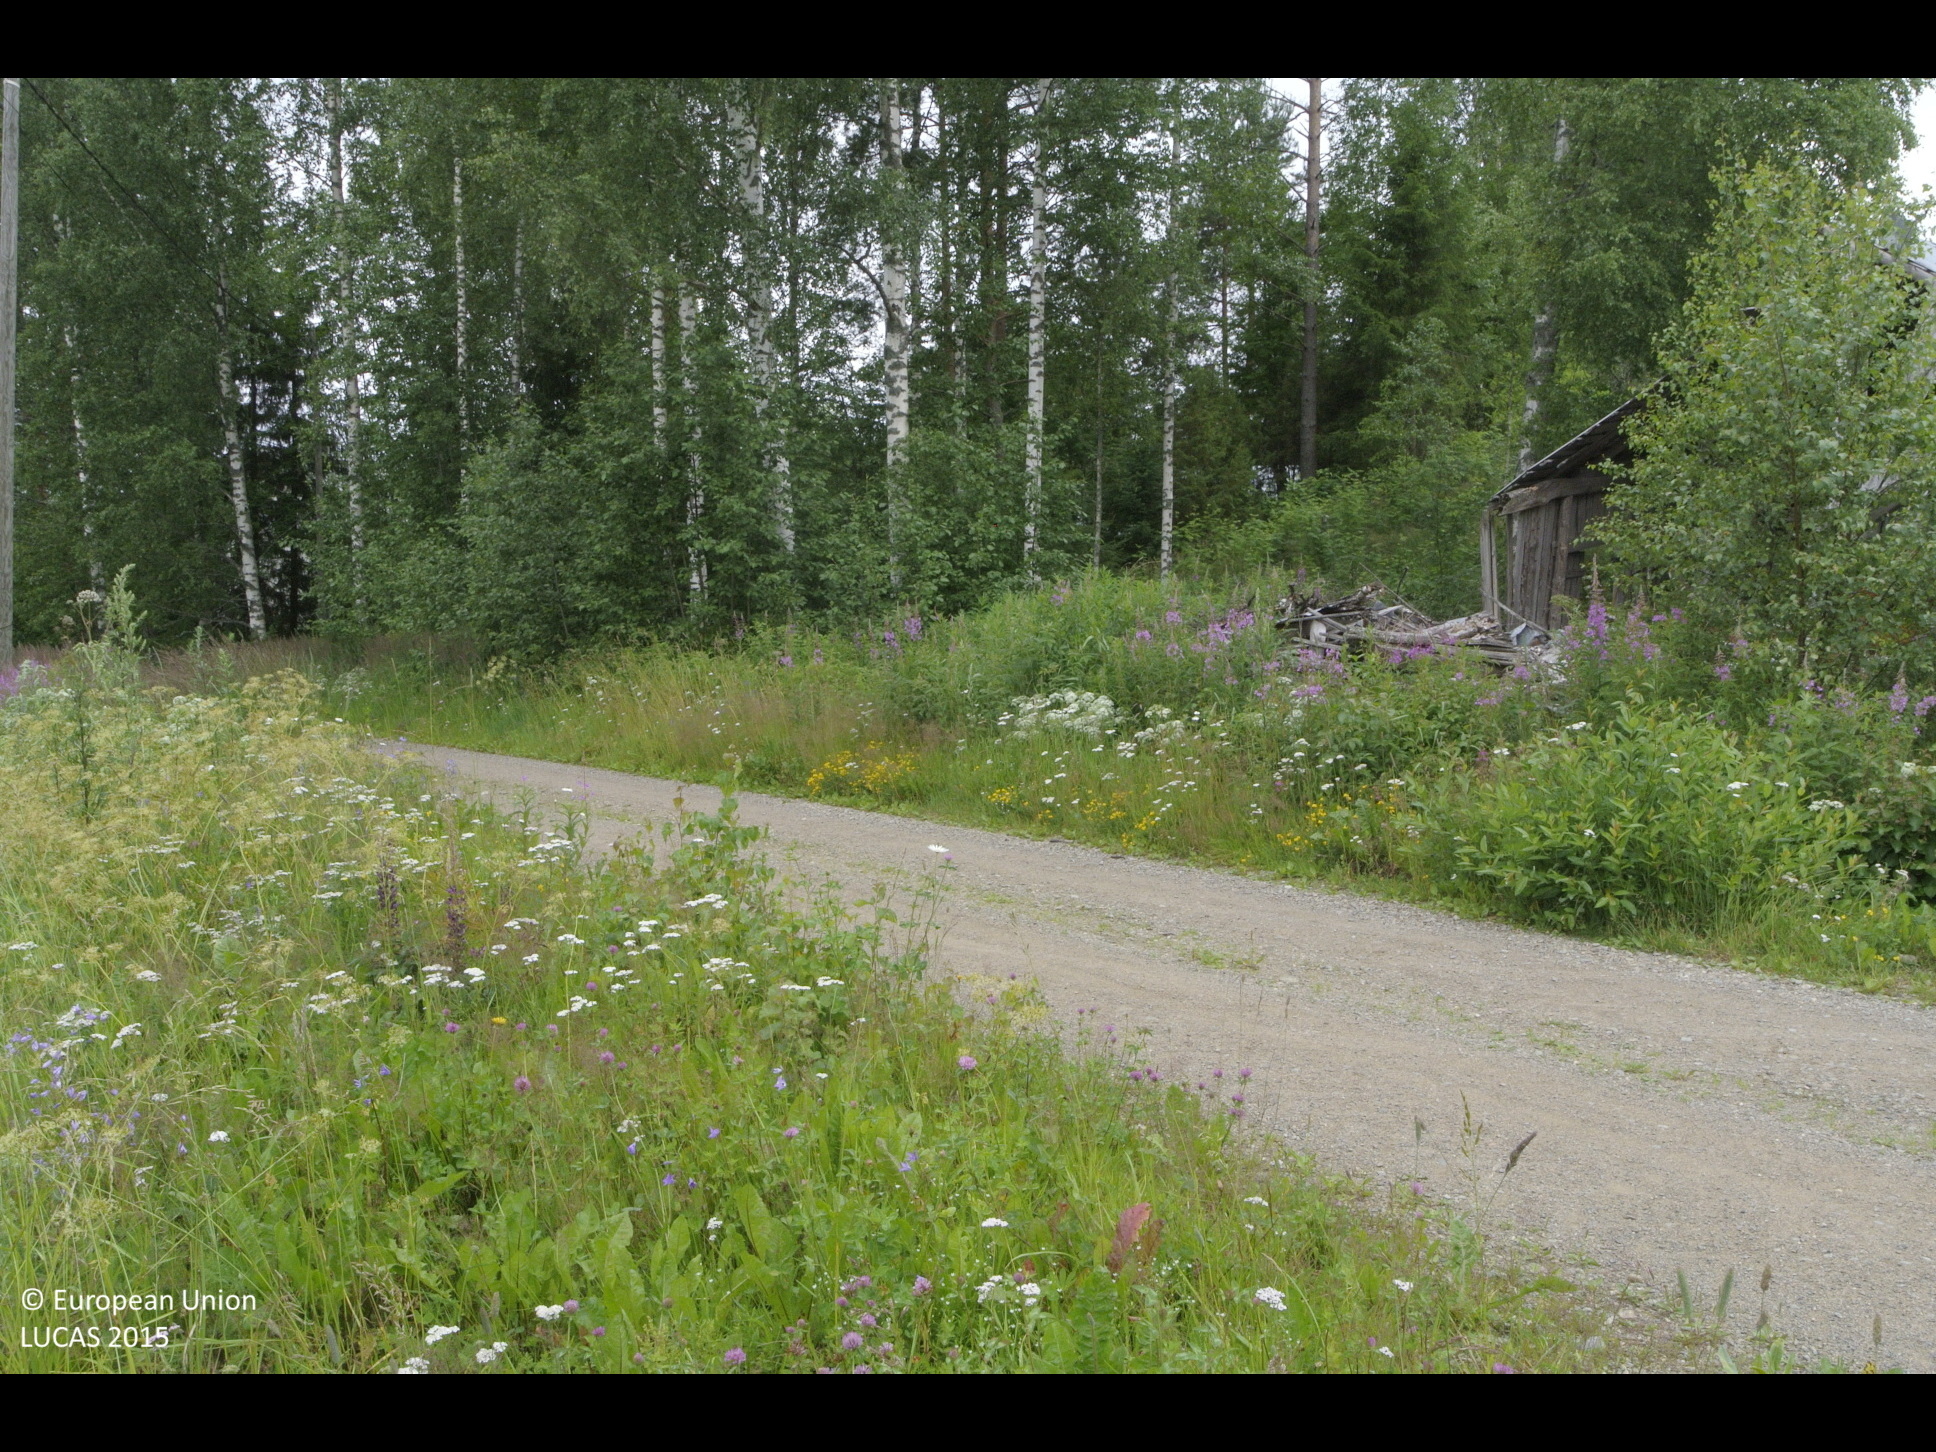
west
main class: Cropland
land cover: Oats
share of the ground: > 75 %
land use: Agriculture (excluding fallow land and kitchen gardens)
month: July
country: FI
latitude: 61.3870
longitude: 25.7588
